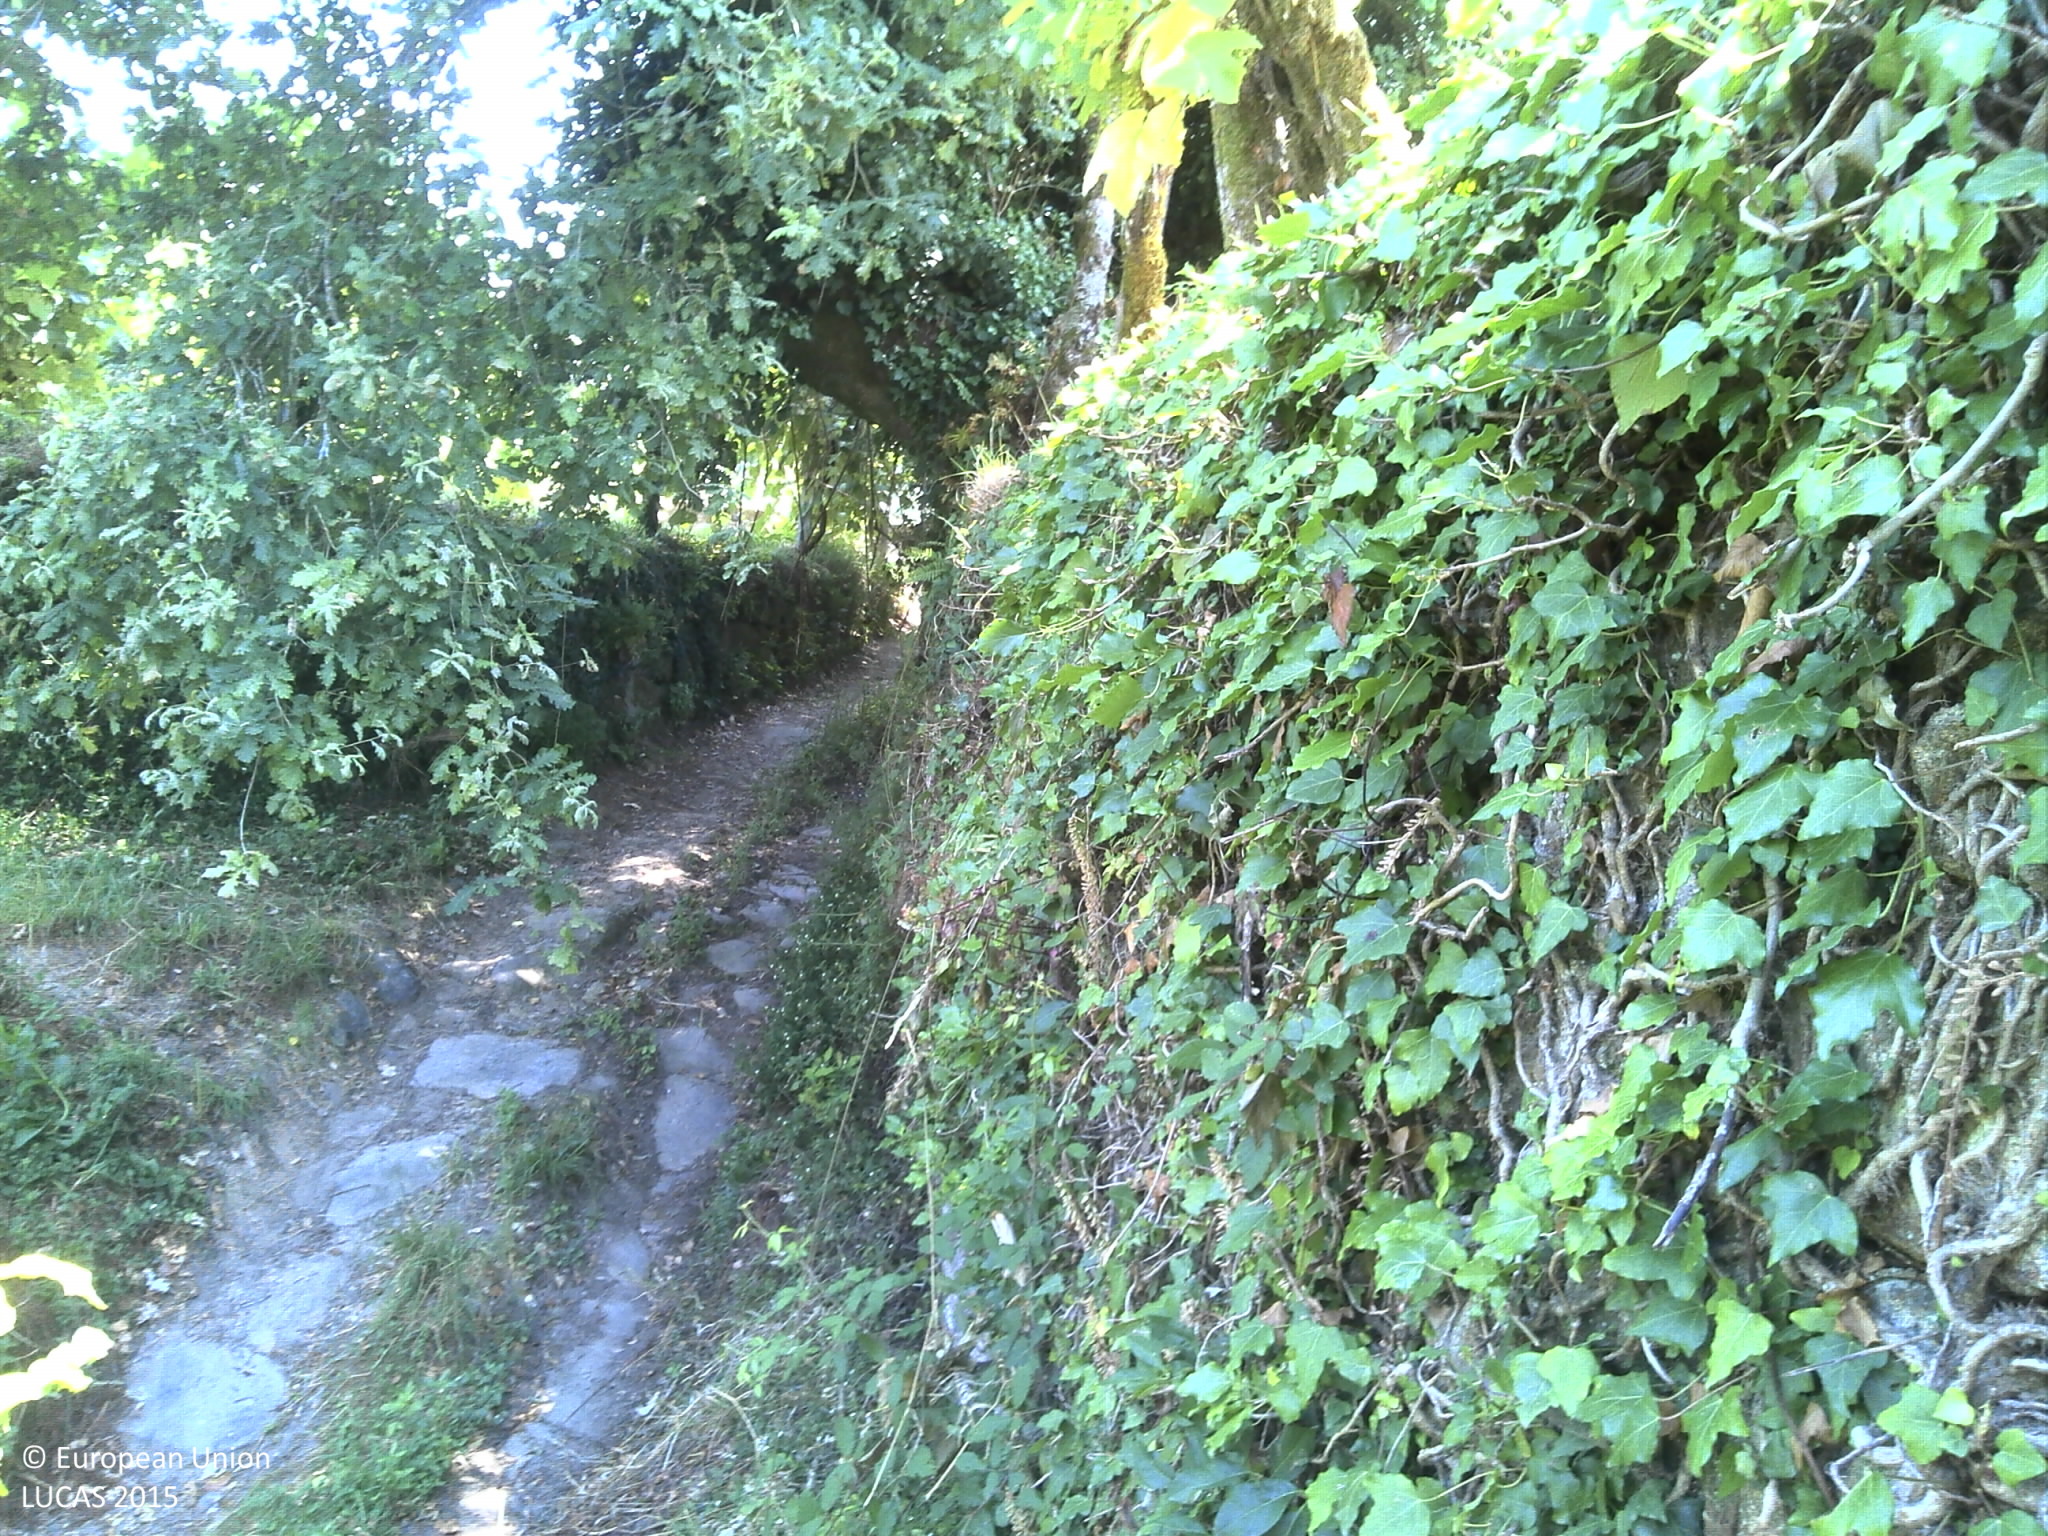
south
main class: Grassland
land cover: Grassland without tree/shrub cover
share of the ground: 50 - 75 %
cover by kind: herbaceous plants 75 %, unconsolidated bare surface 25 %
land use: Agriculture (excluding fallow land and kitchen gardens)
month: June
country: PT
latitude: 40.7276
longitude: -8.3108
